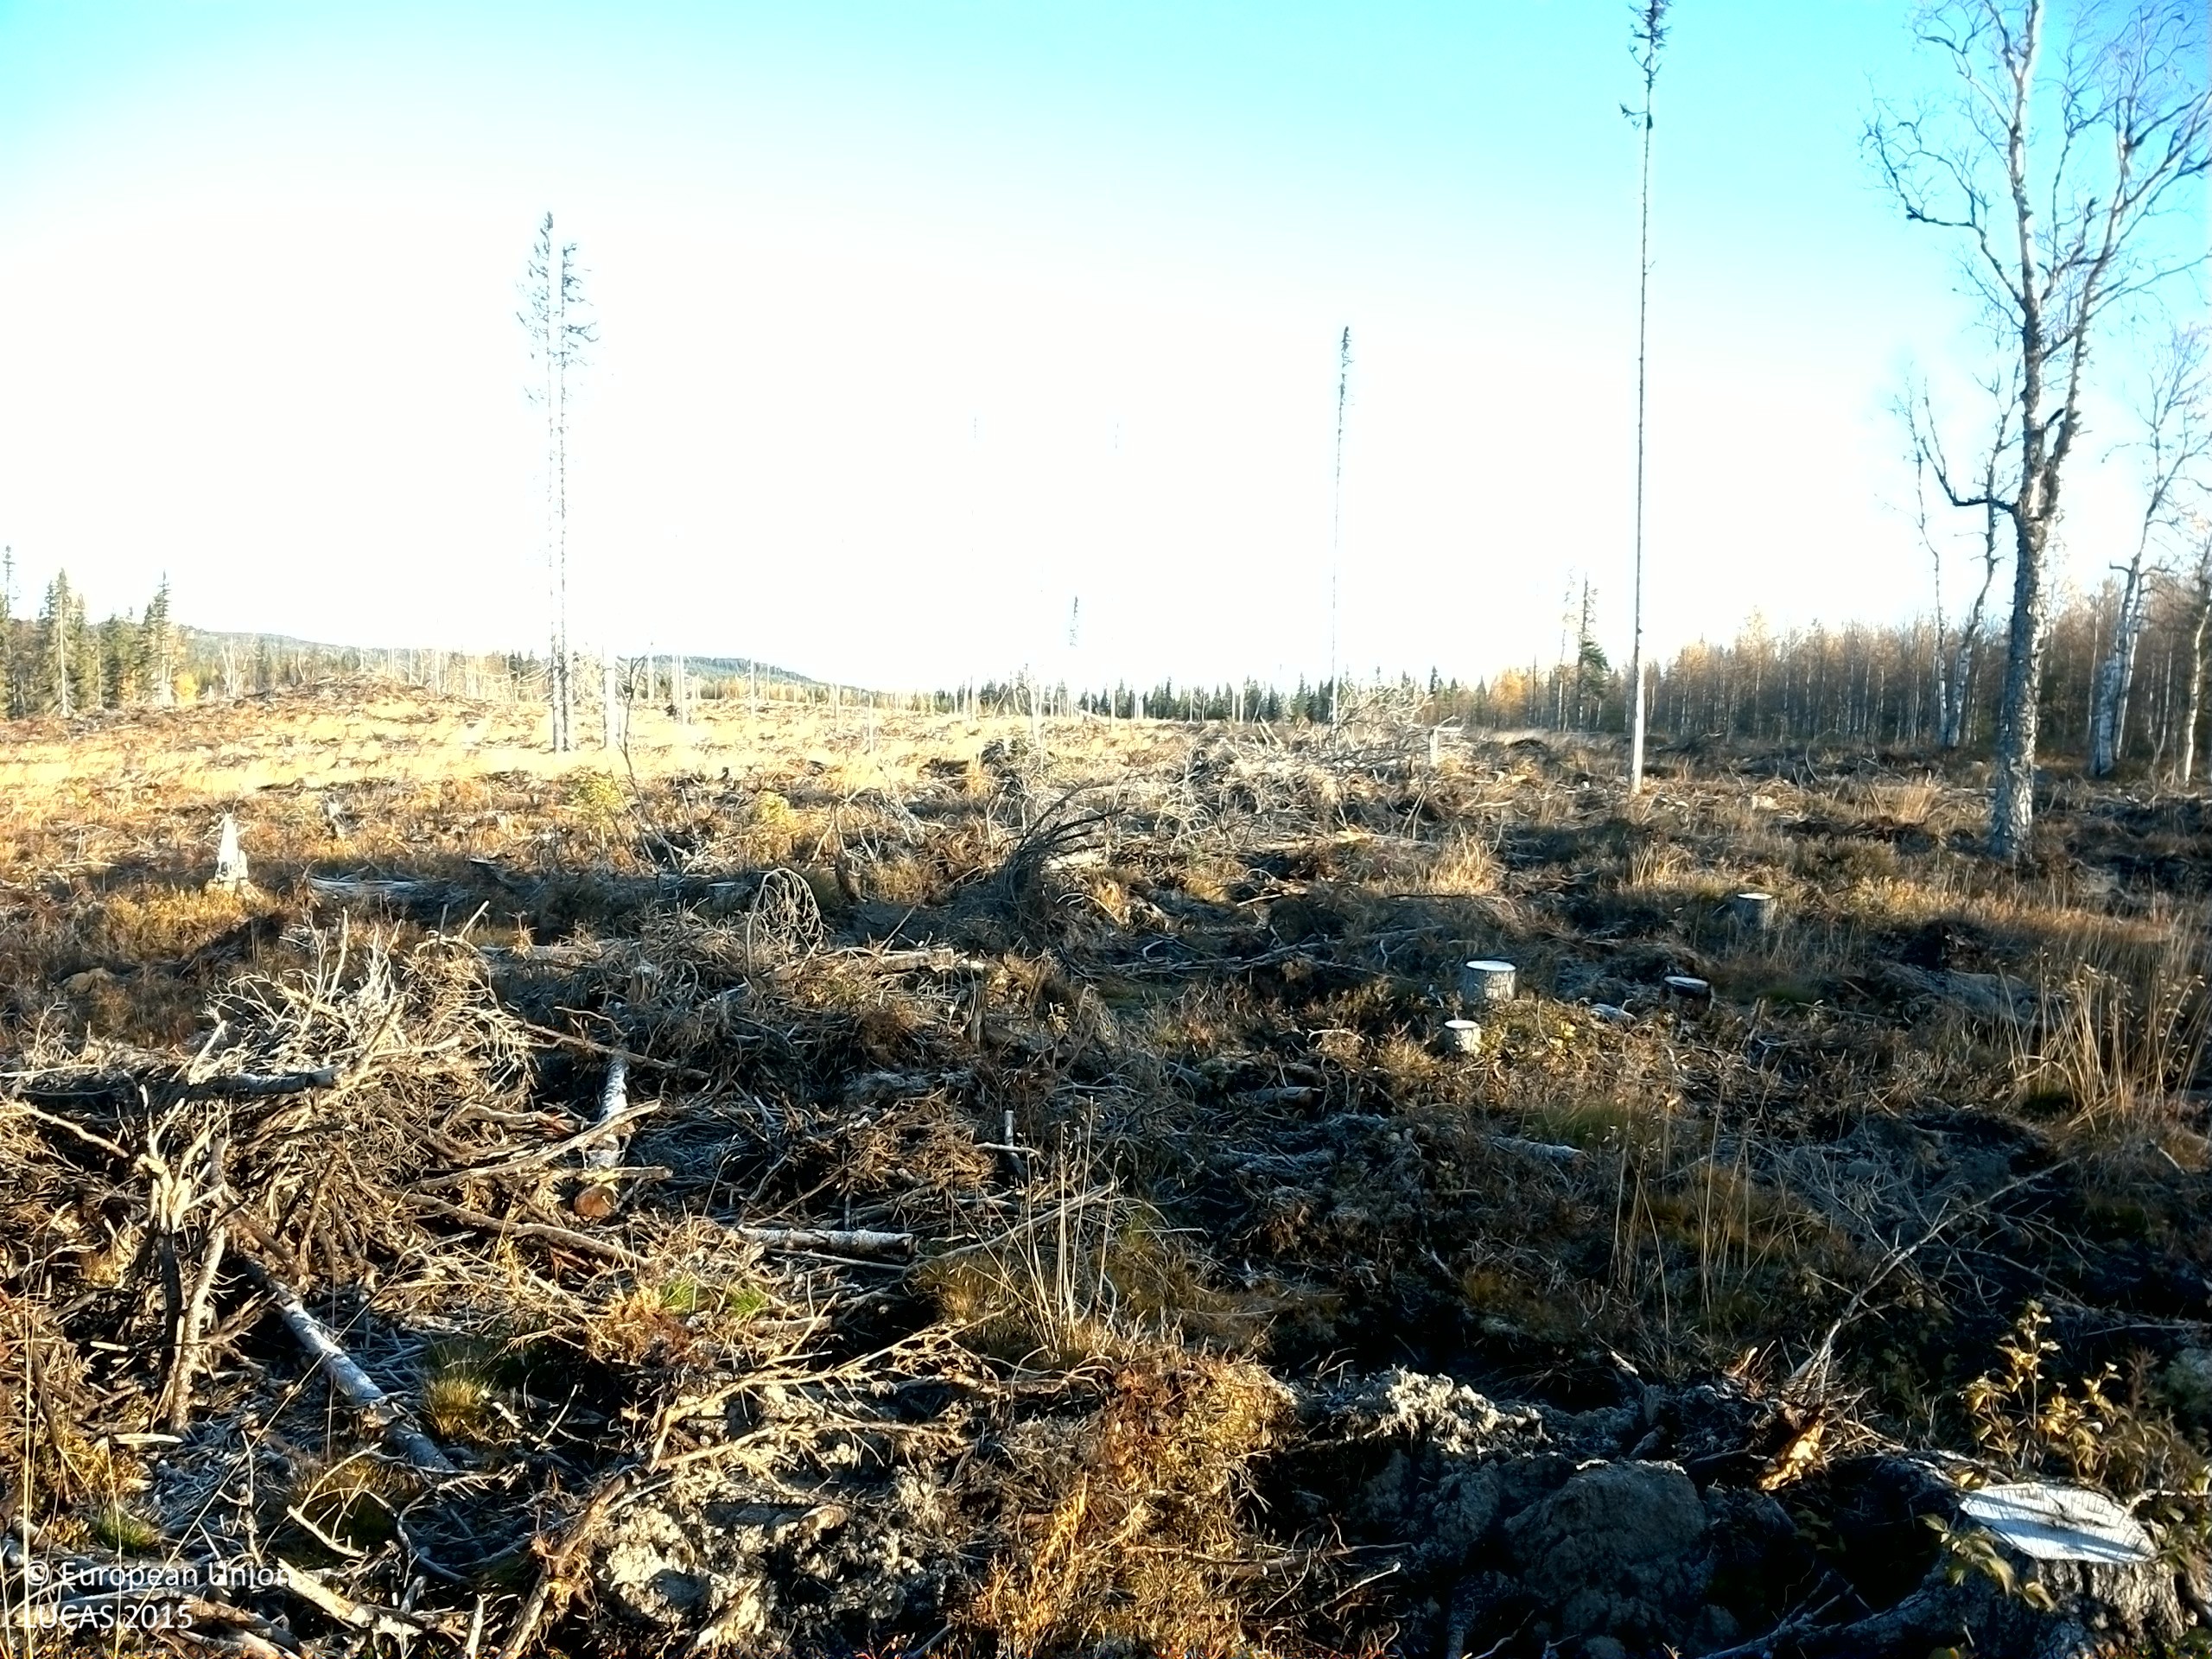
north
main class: Shrubland
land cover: Shrubland without tree cover
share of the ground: 25 - 50 %
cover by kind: shrubs 30 %, herbaceous plants 20 %, lichens and mosses 20 %, unconsolidated bare surface 10 %
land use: Forestry
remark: Clear cut
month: October
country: SE
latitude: 64.2839
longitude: 16.0221
